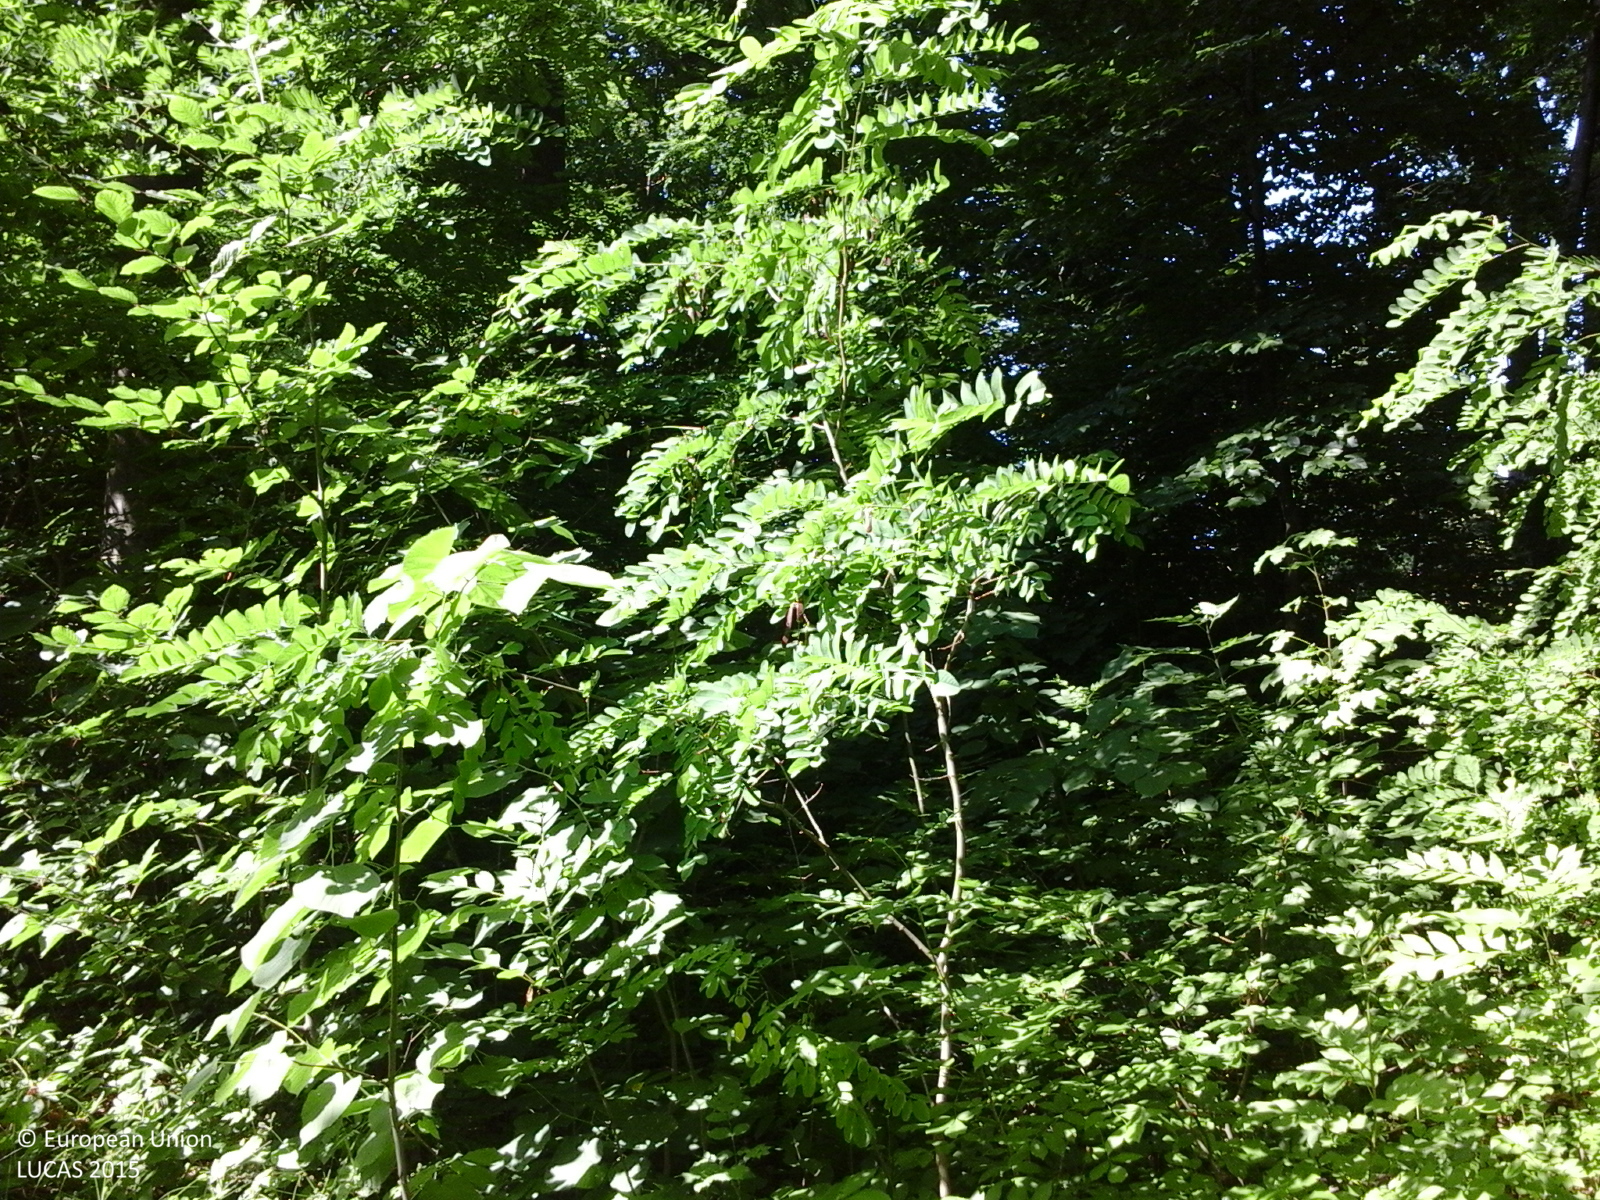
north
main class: Woodland
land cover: Broadleaved woodland
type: mesophytic deciduous forest
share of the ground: > 75 %
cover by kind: broadleaved forest trees 100 %
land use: Forestry
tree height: > 5 m
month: June
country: RO
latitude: 47.0176
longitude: 27.5743
